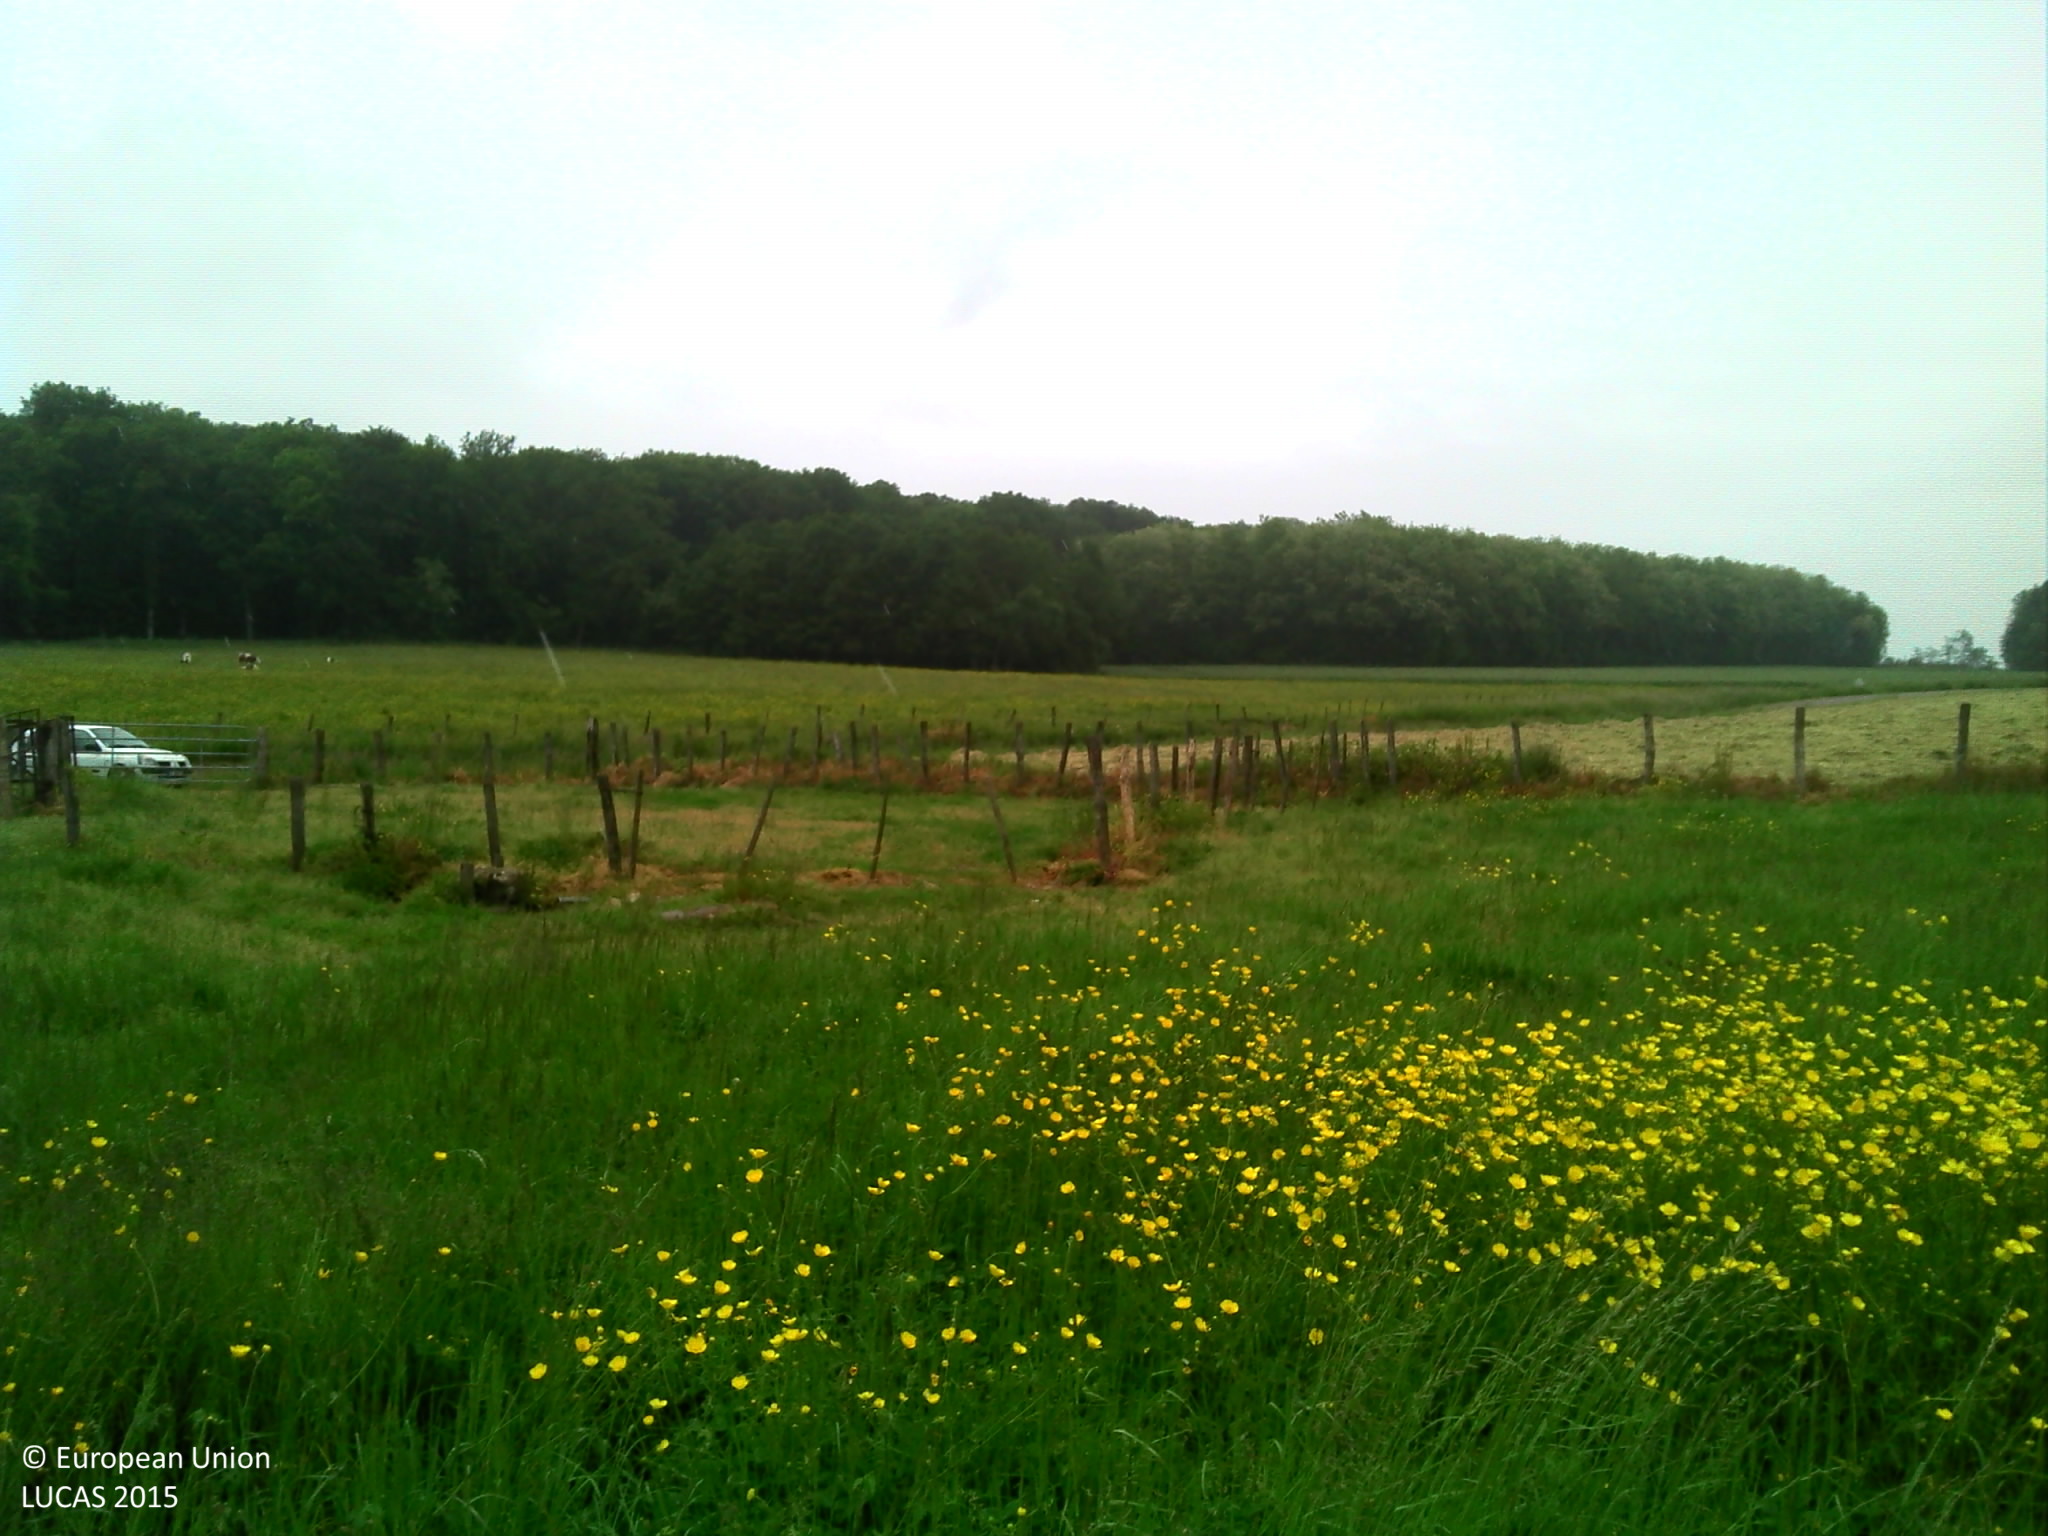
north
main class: Grassland
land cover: Grassland without tree/shrub cover
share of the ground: > 75 %
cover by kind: herbaceous plants 100 %
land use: Agriculture (excluding fallow land and kitchen gardens)
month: May
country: FR
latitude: 47.7920
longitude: 6.0362
